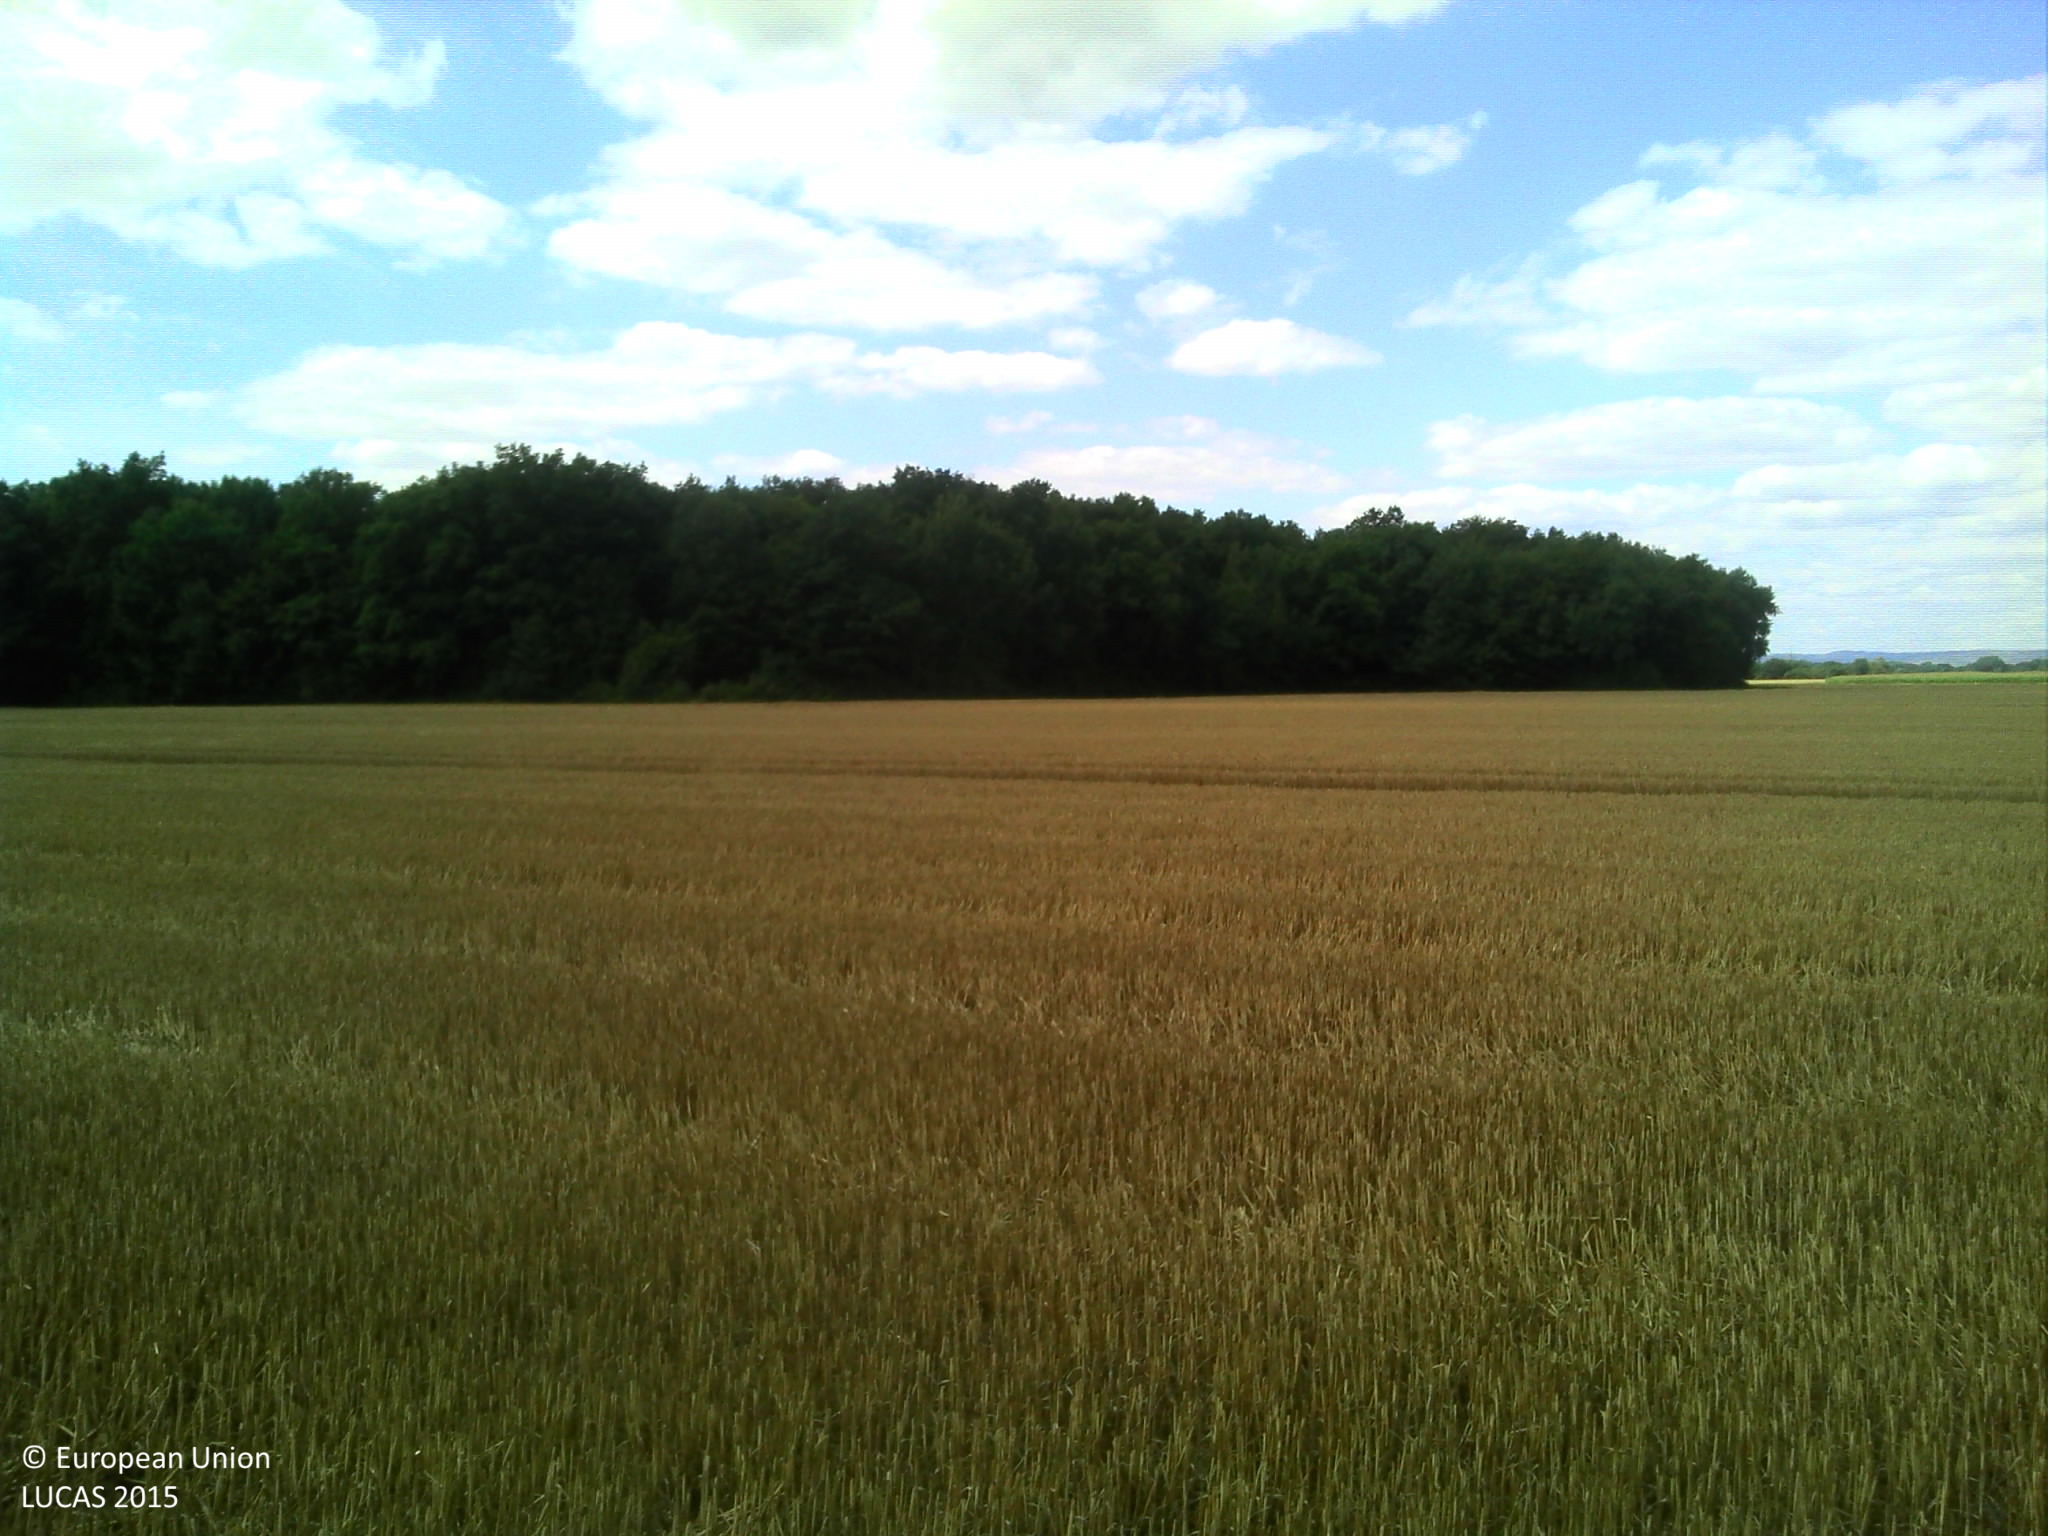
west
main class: Cropland
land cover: Common wheat
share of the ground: > 75 %
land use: Agriculture (excluding fallow land and kitchen gardens)
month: July
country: FR
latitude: 46.6814
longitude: 4.9159
